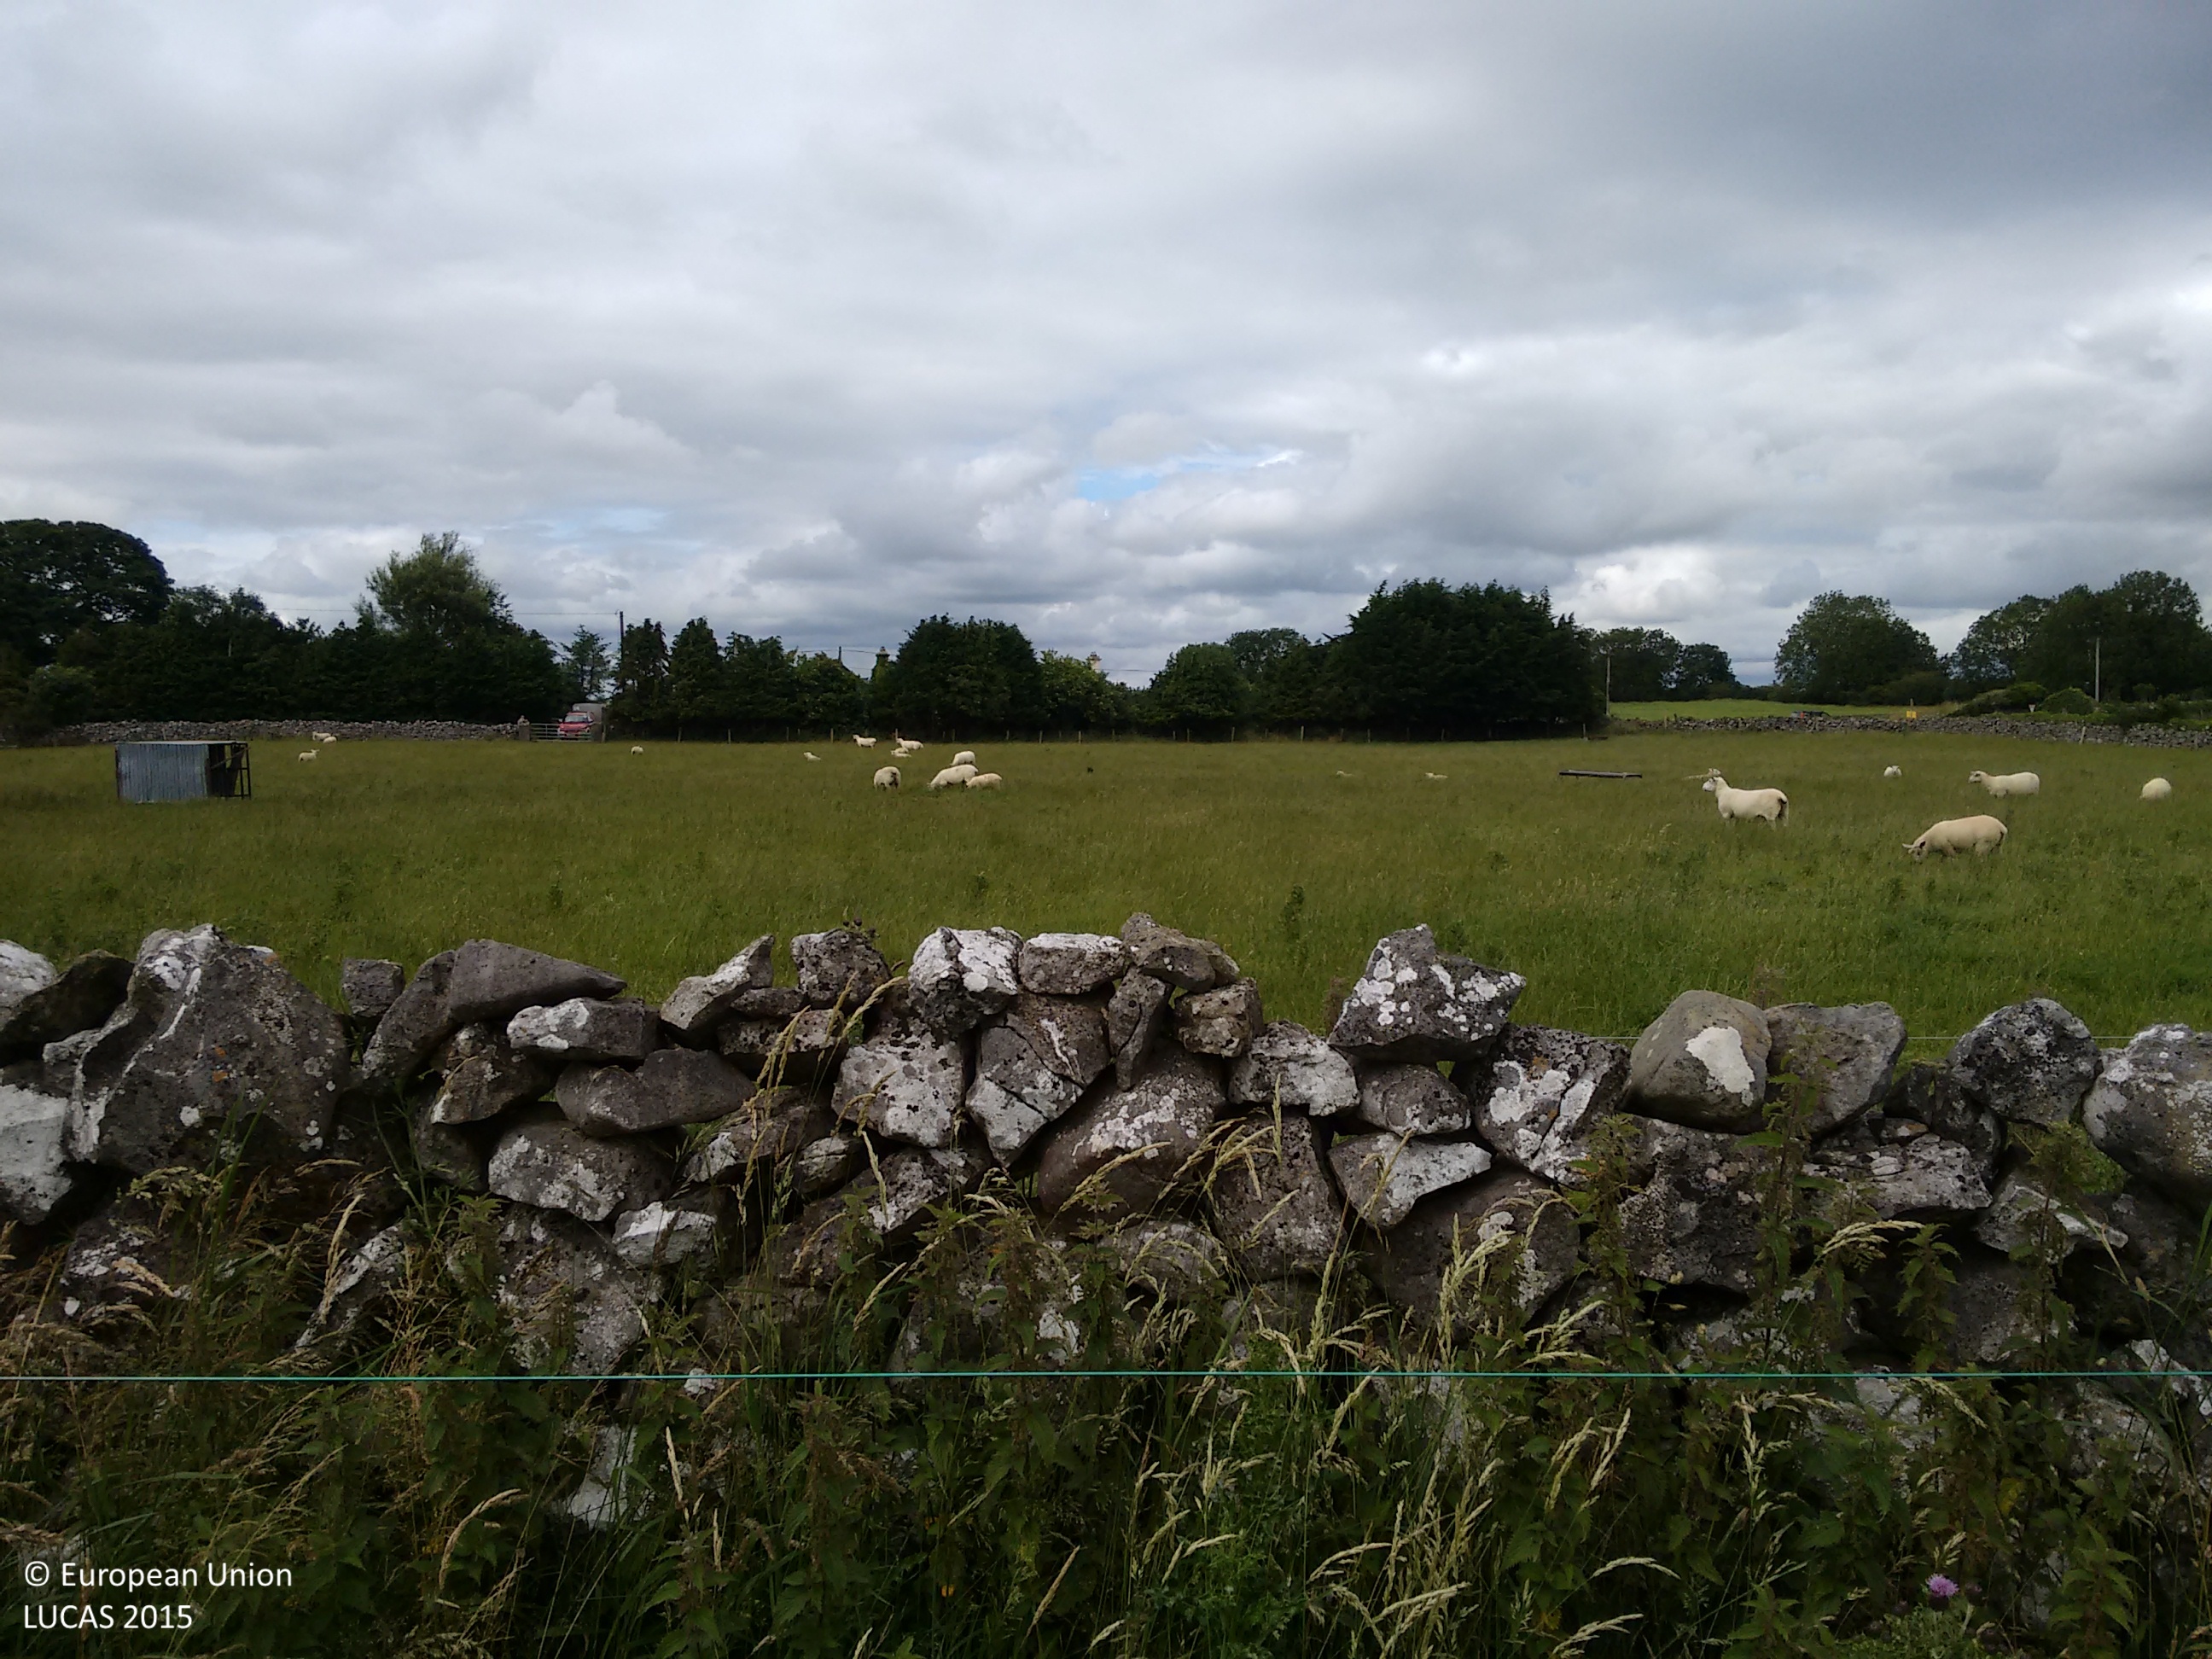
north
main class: Grassland
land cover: Grassland without tree/shrub cover
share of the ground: > 75 %
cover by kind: herbaceous plants 100 %
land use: Agriculture (excluding fallow land and kitchen gardens)
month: July
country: IE
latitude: 53.6413
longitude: -9.0771
